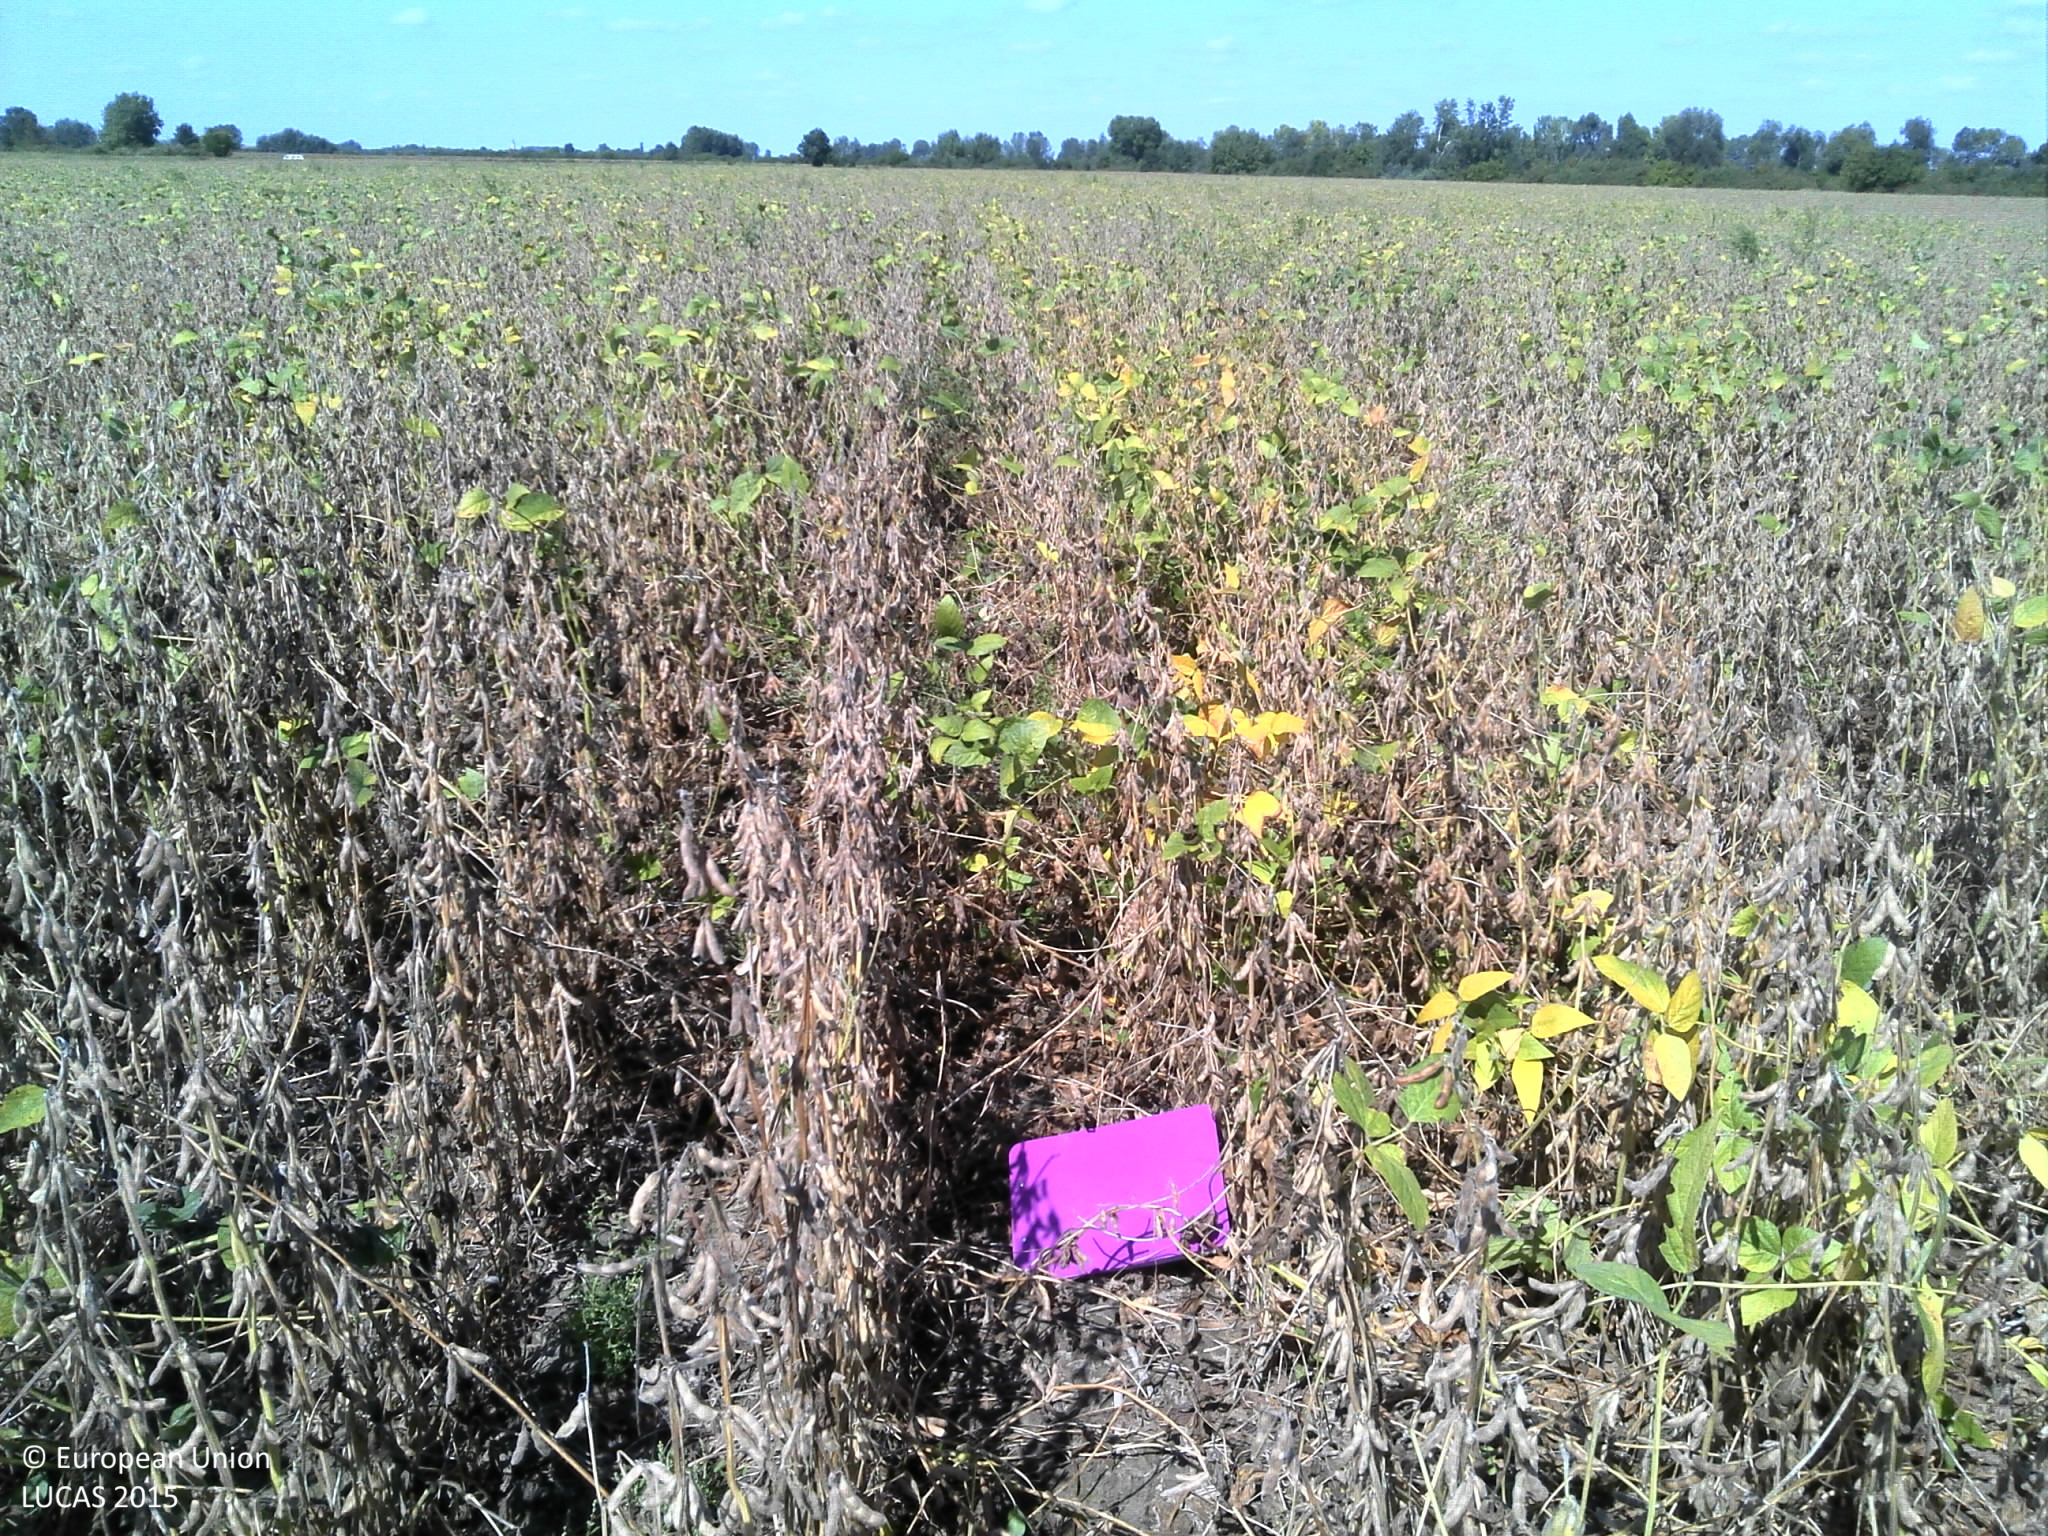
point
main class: Cropland
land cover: Soya
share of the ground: > 75 %
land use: Agriculture (excluding fallow land and kitchen gardens)
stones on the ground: < 10 %
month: September
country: HR
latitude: 44.9367
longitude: 19.0166
